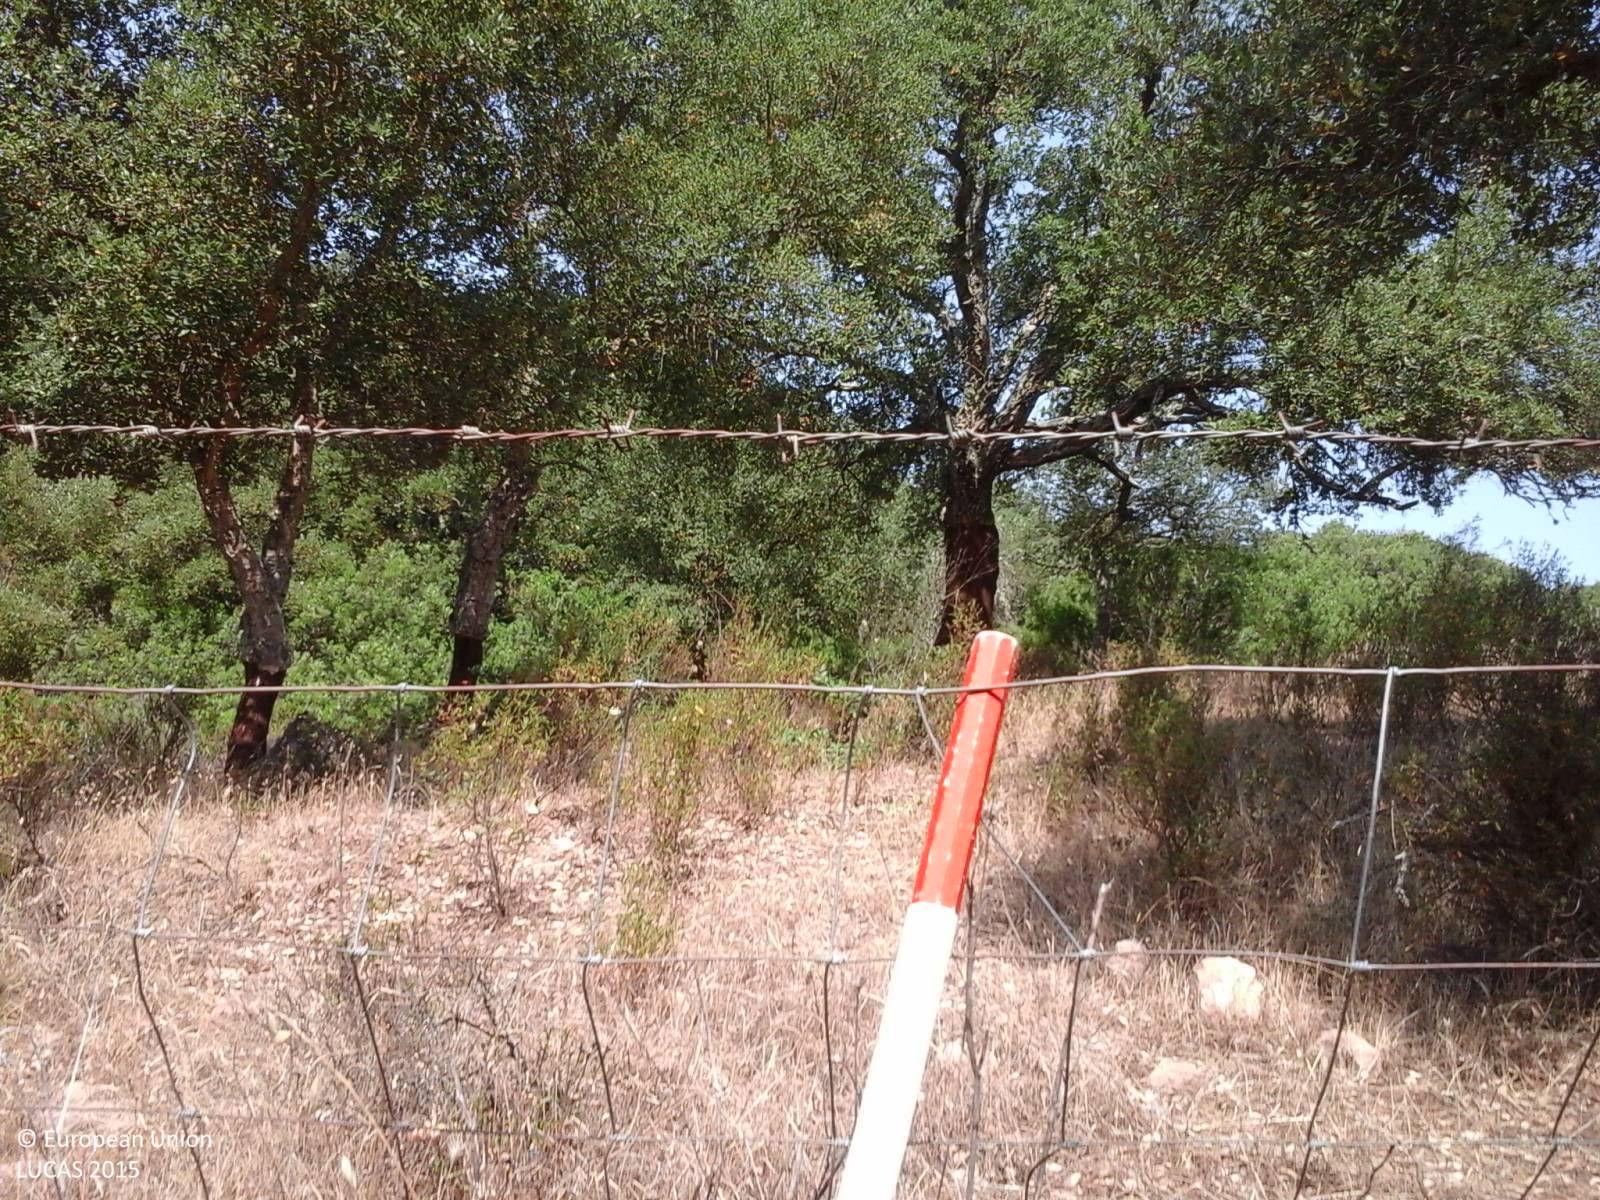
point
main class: Woodland
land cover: Broadleaved woodland
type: broadleaved evergreen forest
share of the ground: > 75 %
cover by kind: broadleaved forest trees 100 %
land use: Forestry
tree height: < 5 m
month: July
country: IT
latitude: 39.9349
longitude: 8.8711
